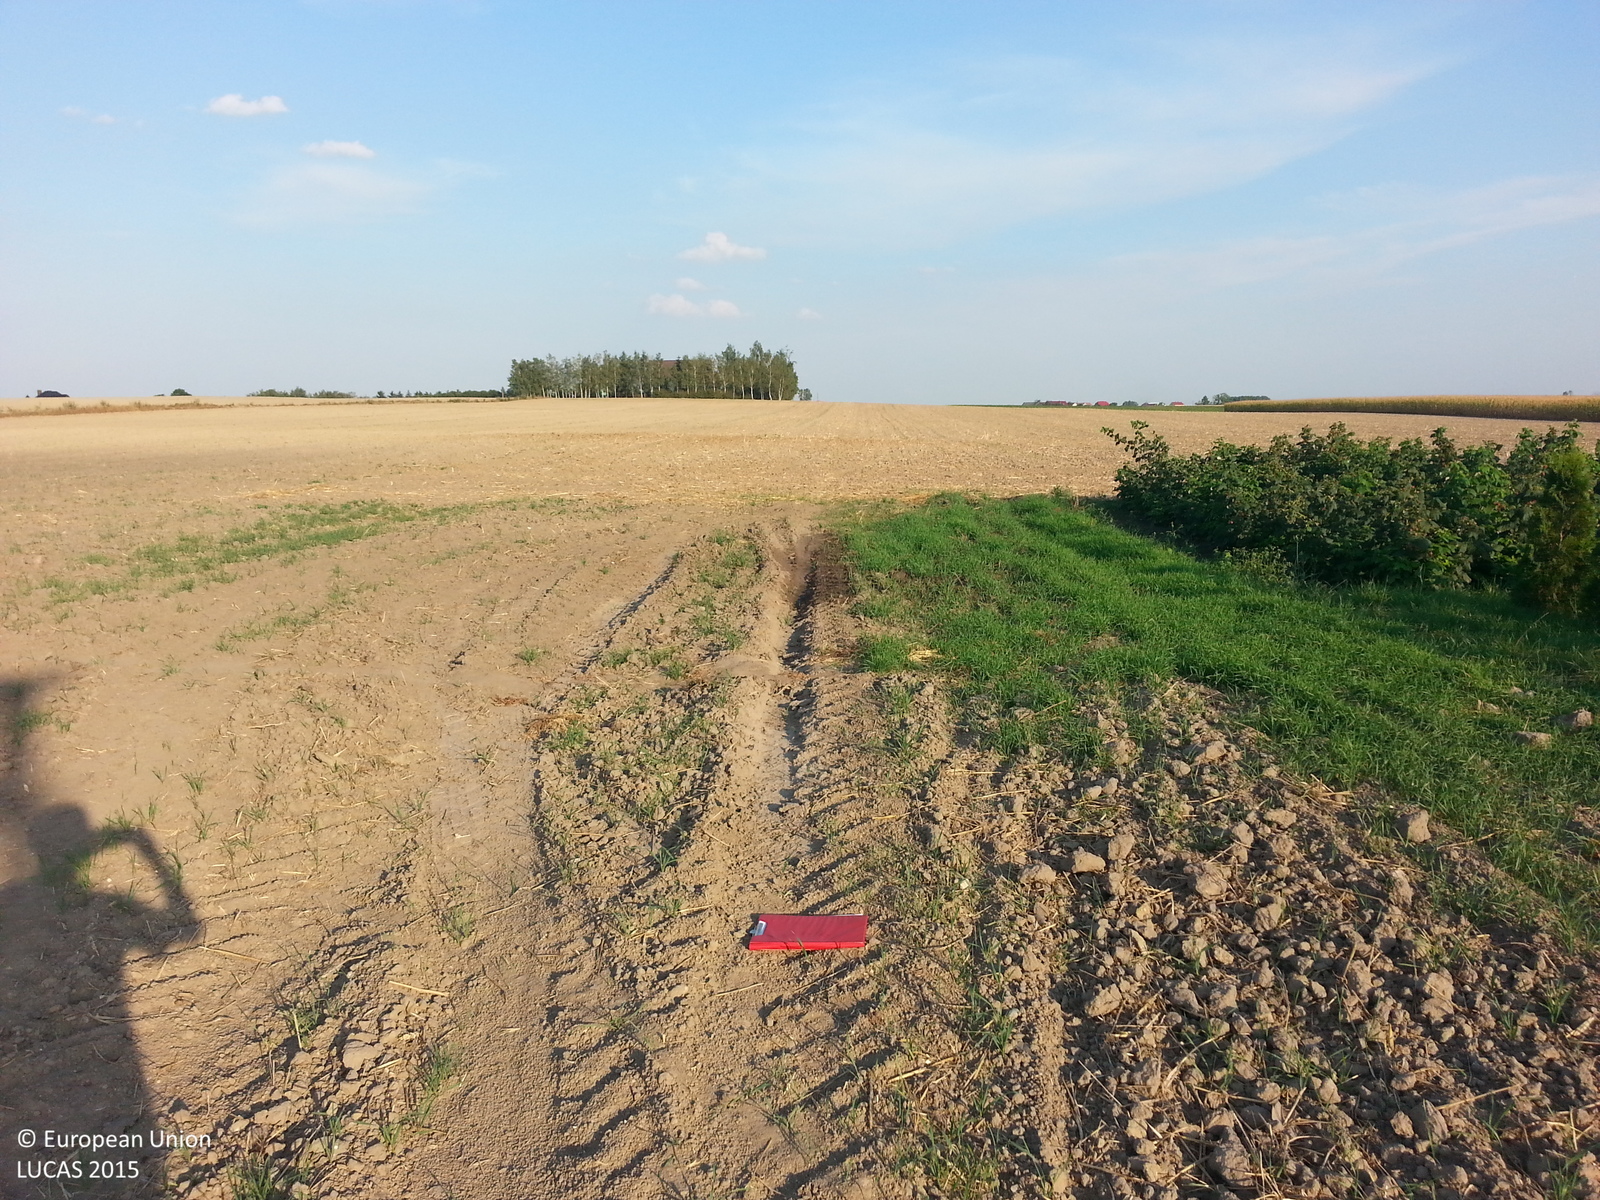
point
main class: Cropland
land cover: Common wheat
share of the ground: < 10 %
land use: Agriculture (excluding fallow land and kitchen gardens)
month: August
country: PL
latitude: 53.0535
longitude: 19.1695
